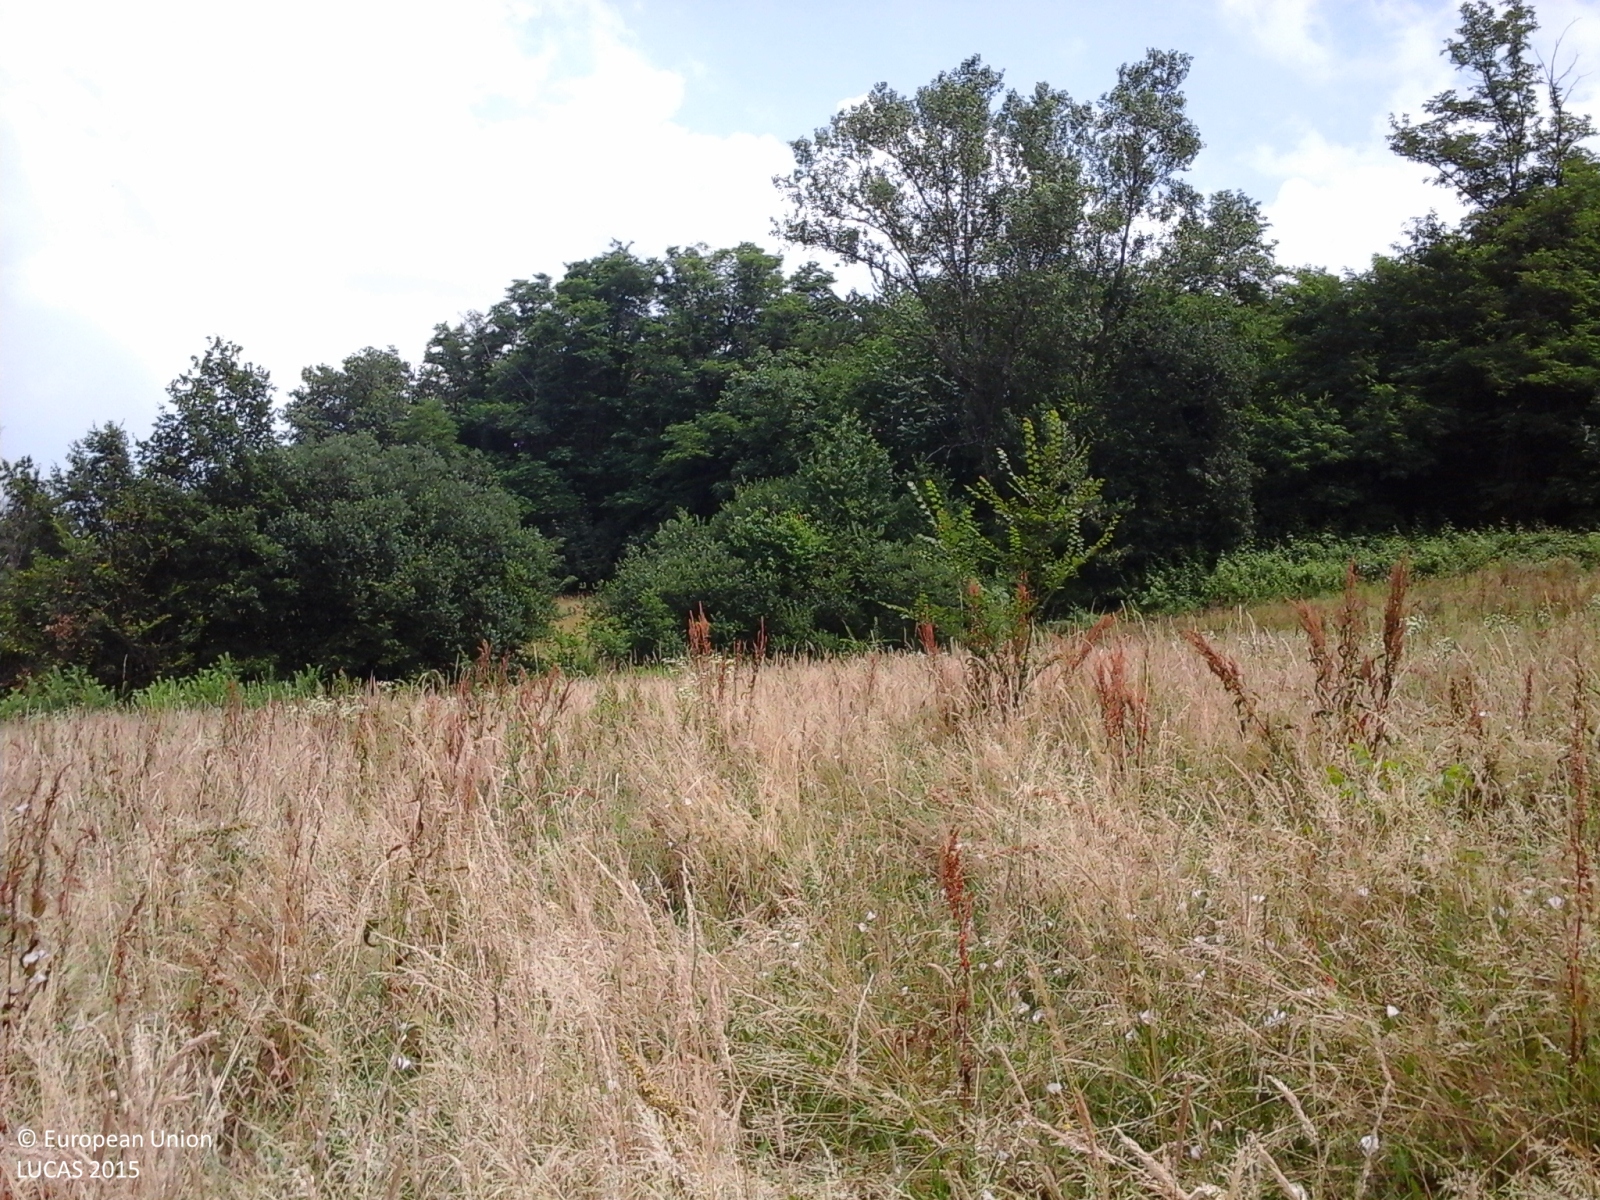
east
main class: Grassland
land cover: Grassland without tree/shrub cover
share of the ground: > 75 %
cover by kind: herbaceous plants 100 %
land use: Agriculture (excluding fallow land and kitchen gardens)
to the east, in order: Grassland without tree/shrub cover; Broadleaved woodland; Grassland without tree/shrub cover; Broadleaved woodland; Vineyards
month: June
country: IT
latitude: 44.8730
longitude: 9.6589
